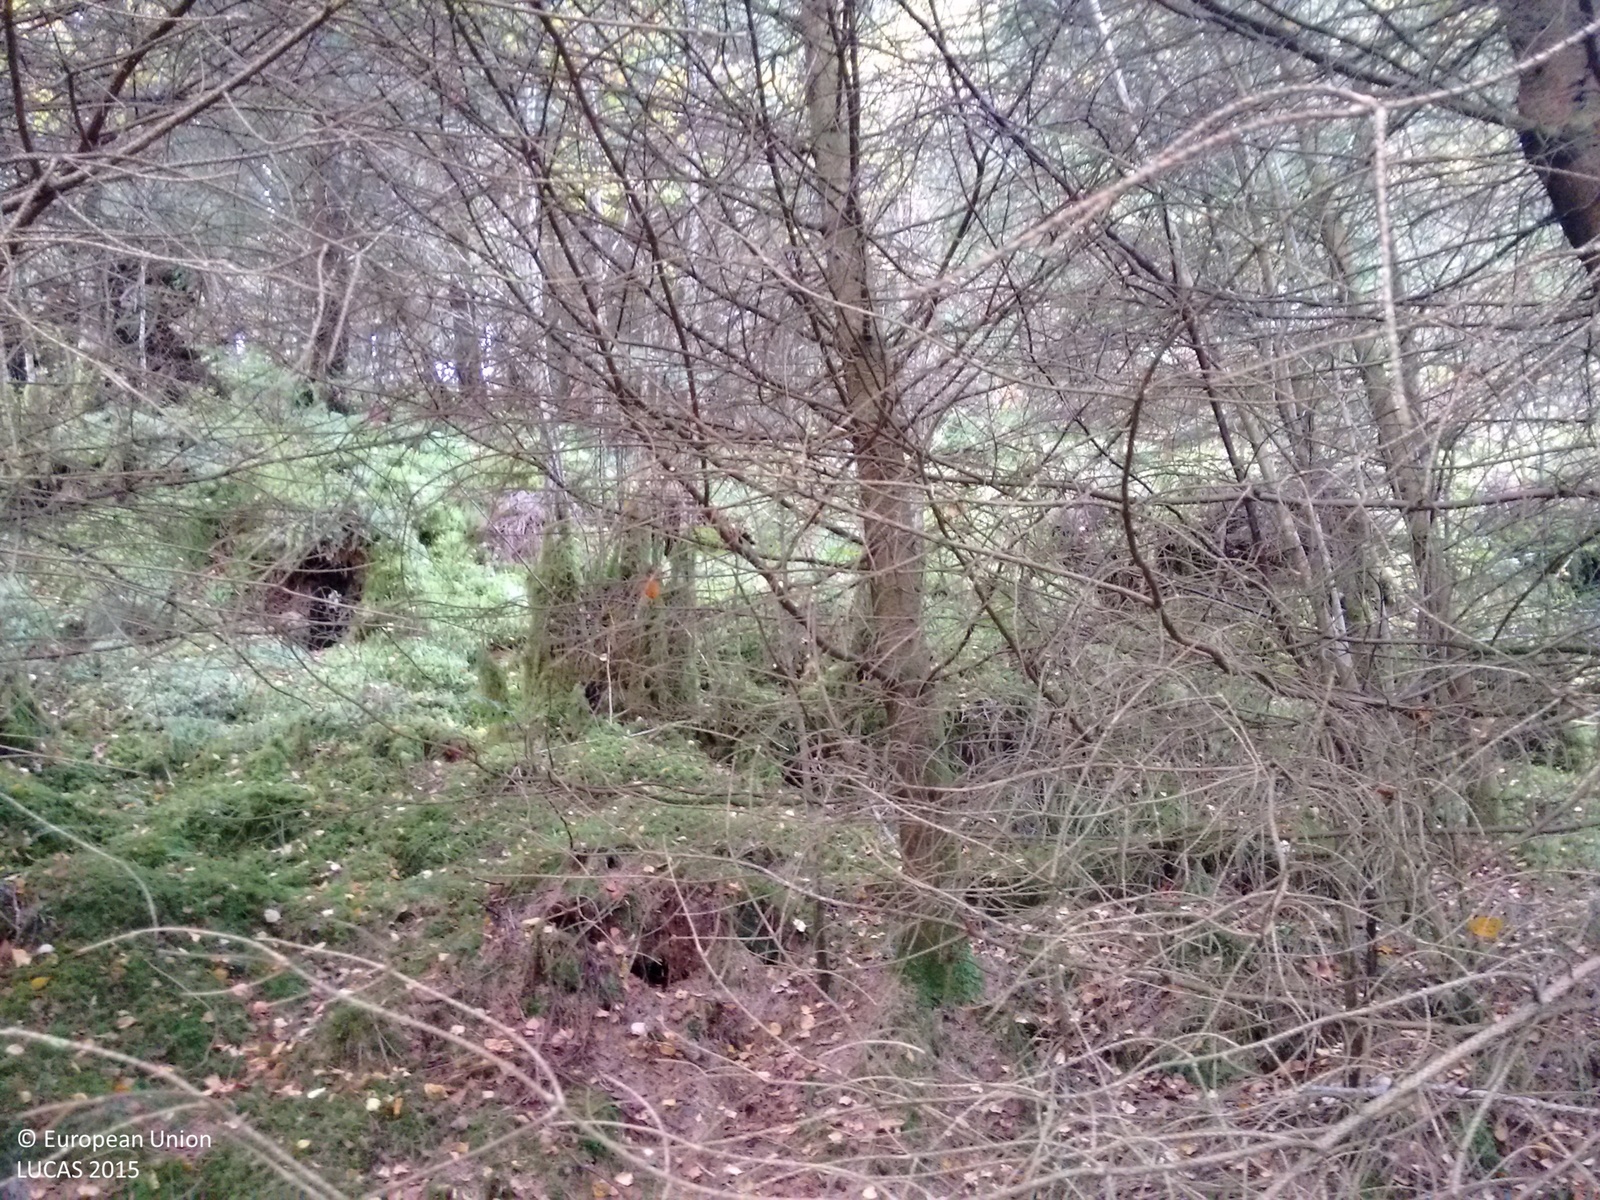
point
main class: Woodland
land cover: Pine dominated coniferous woodland
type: exotic forest
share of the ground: > 75 %
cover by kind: coniferous forest trees 100 %
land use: Forestry
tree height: > 5 m
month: October
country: GB
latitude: 52.5217
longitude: -3.9020
